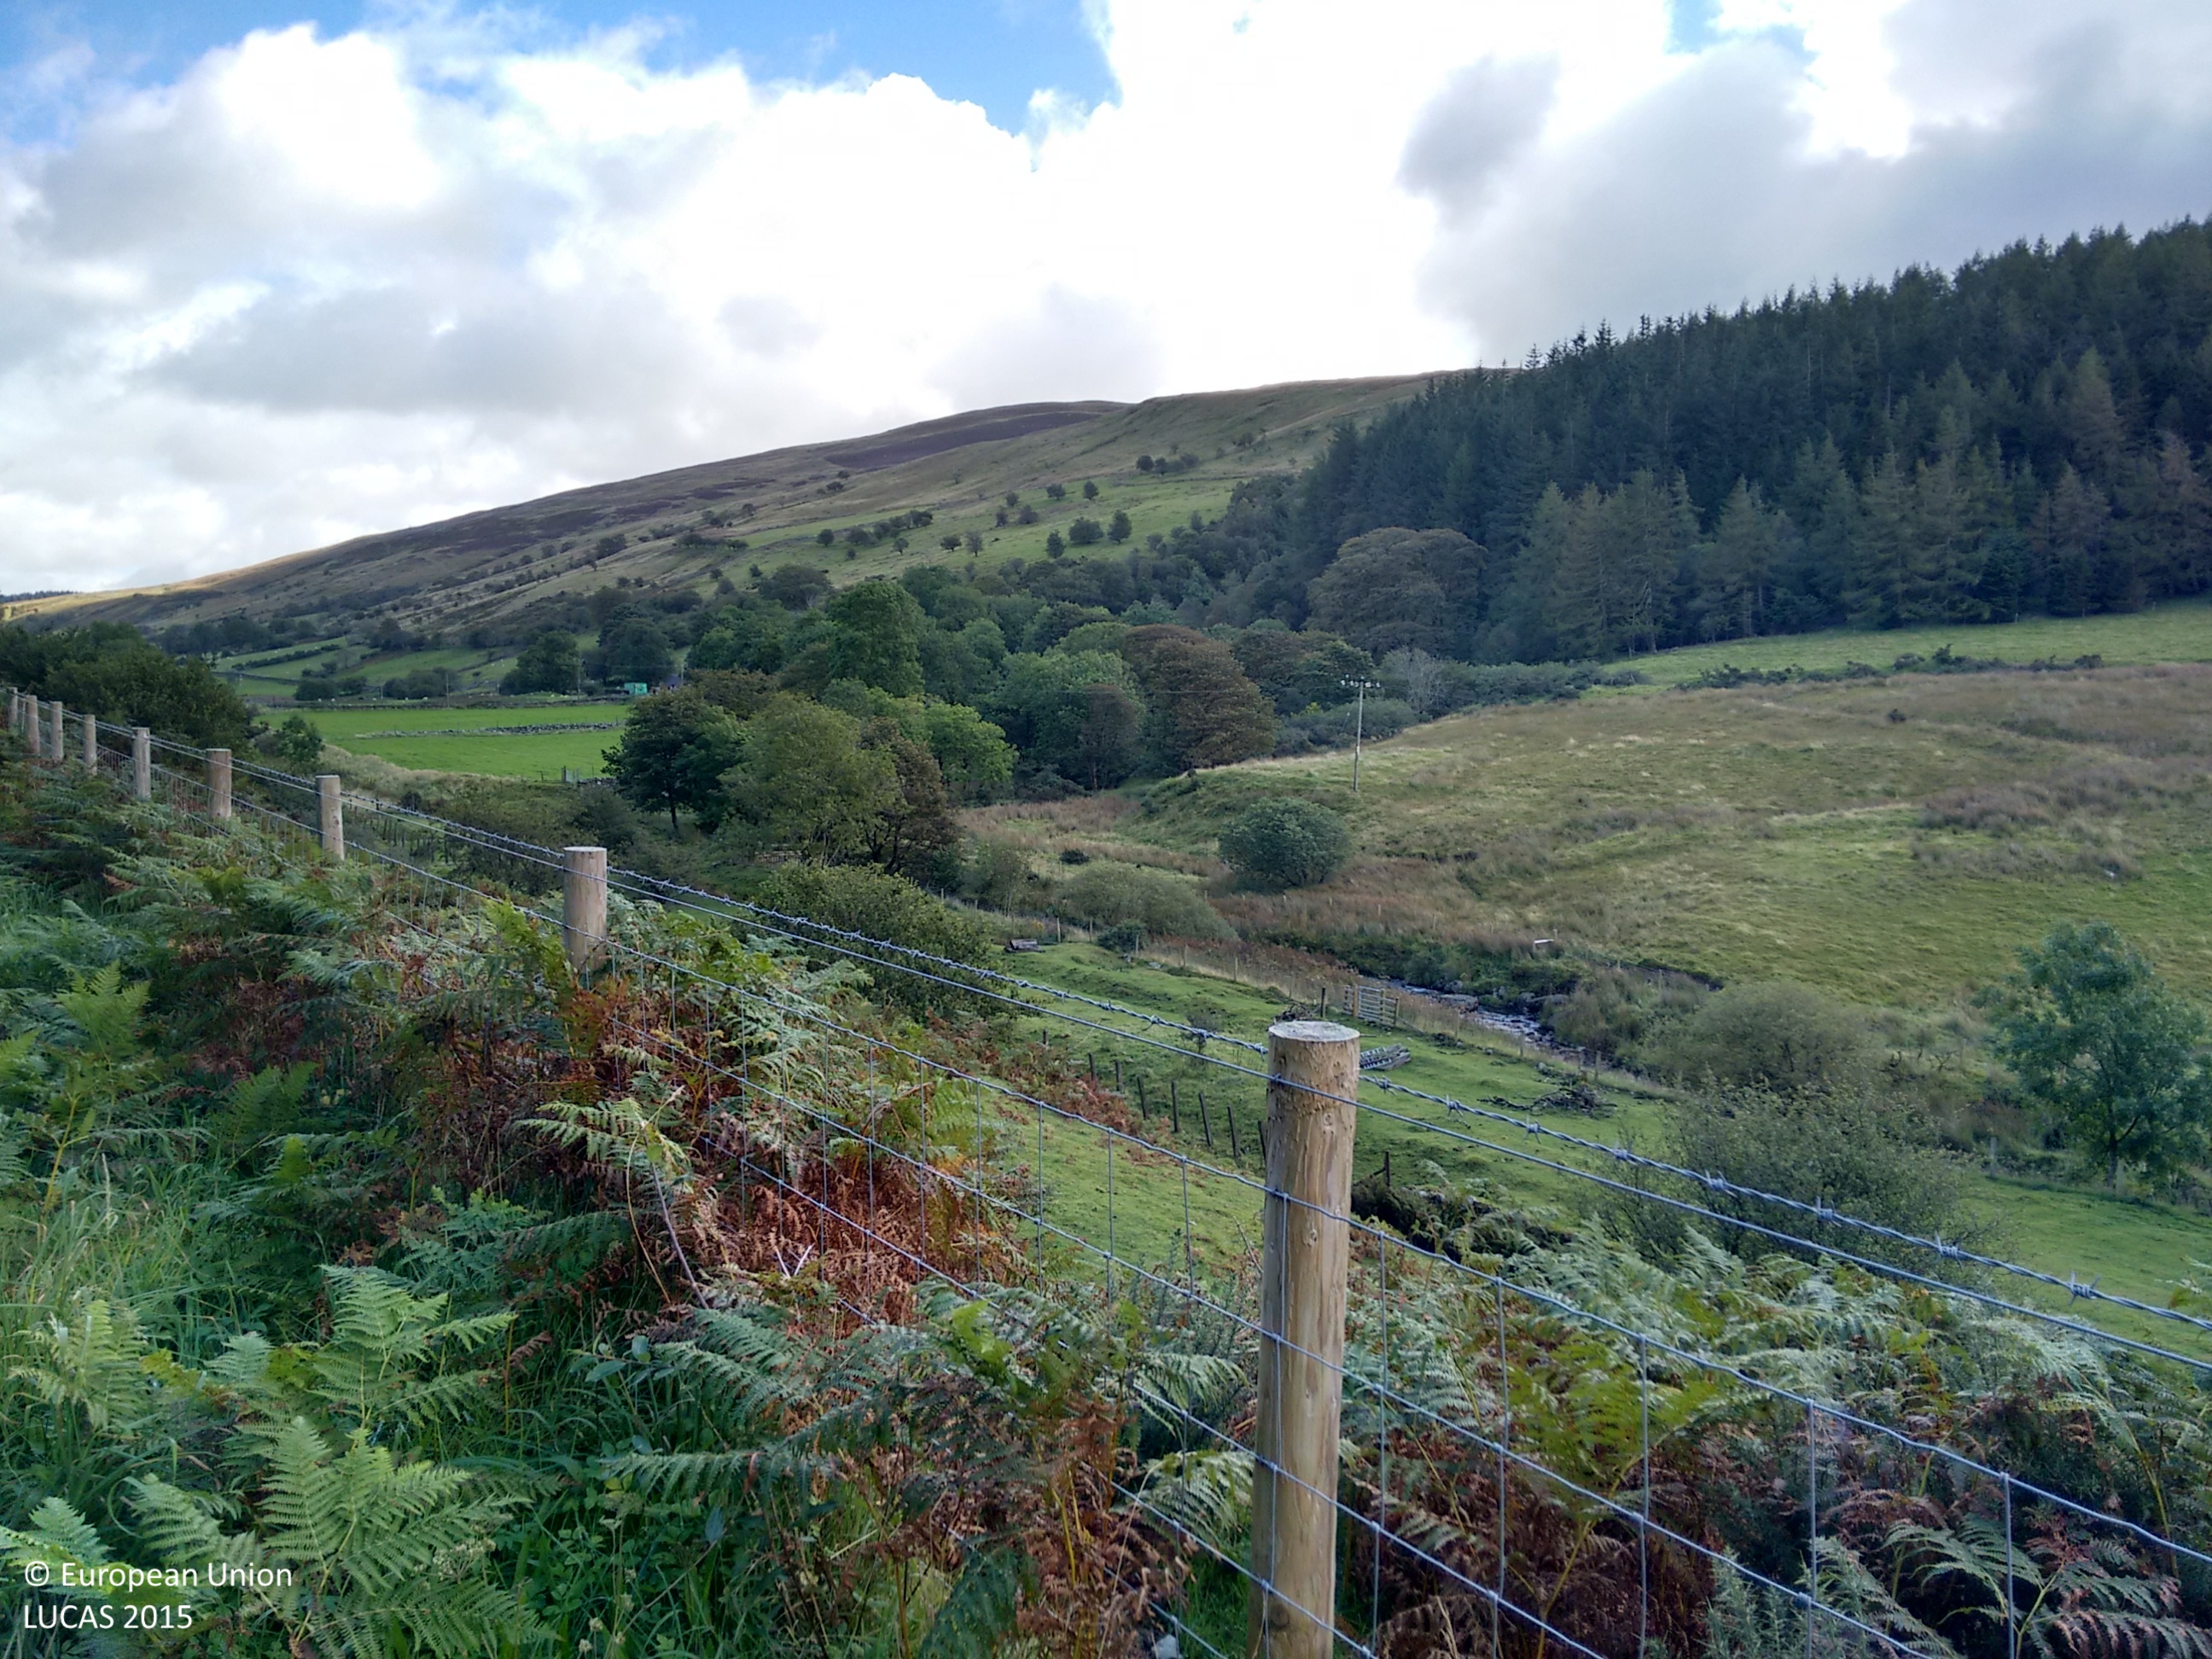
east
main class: Woodland
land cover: Other coniferous woodland
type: exotic forest
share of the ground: > 75 %
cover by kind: coniferous forest trees 100 %
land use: Forestry
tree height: > 5 m
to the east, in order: Other coniferous woodland
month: September
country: GB
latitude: 52.8163
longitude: -3.7244
